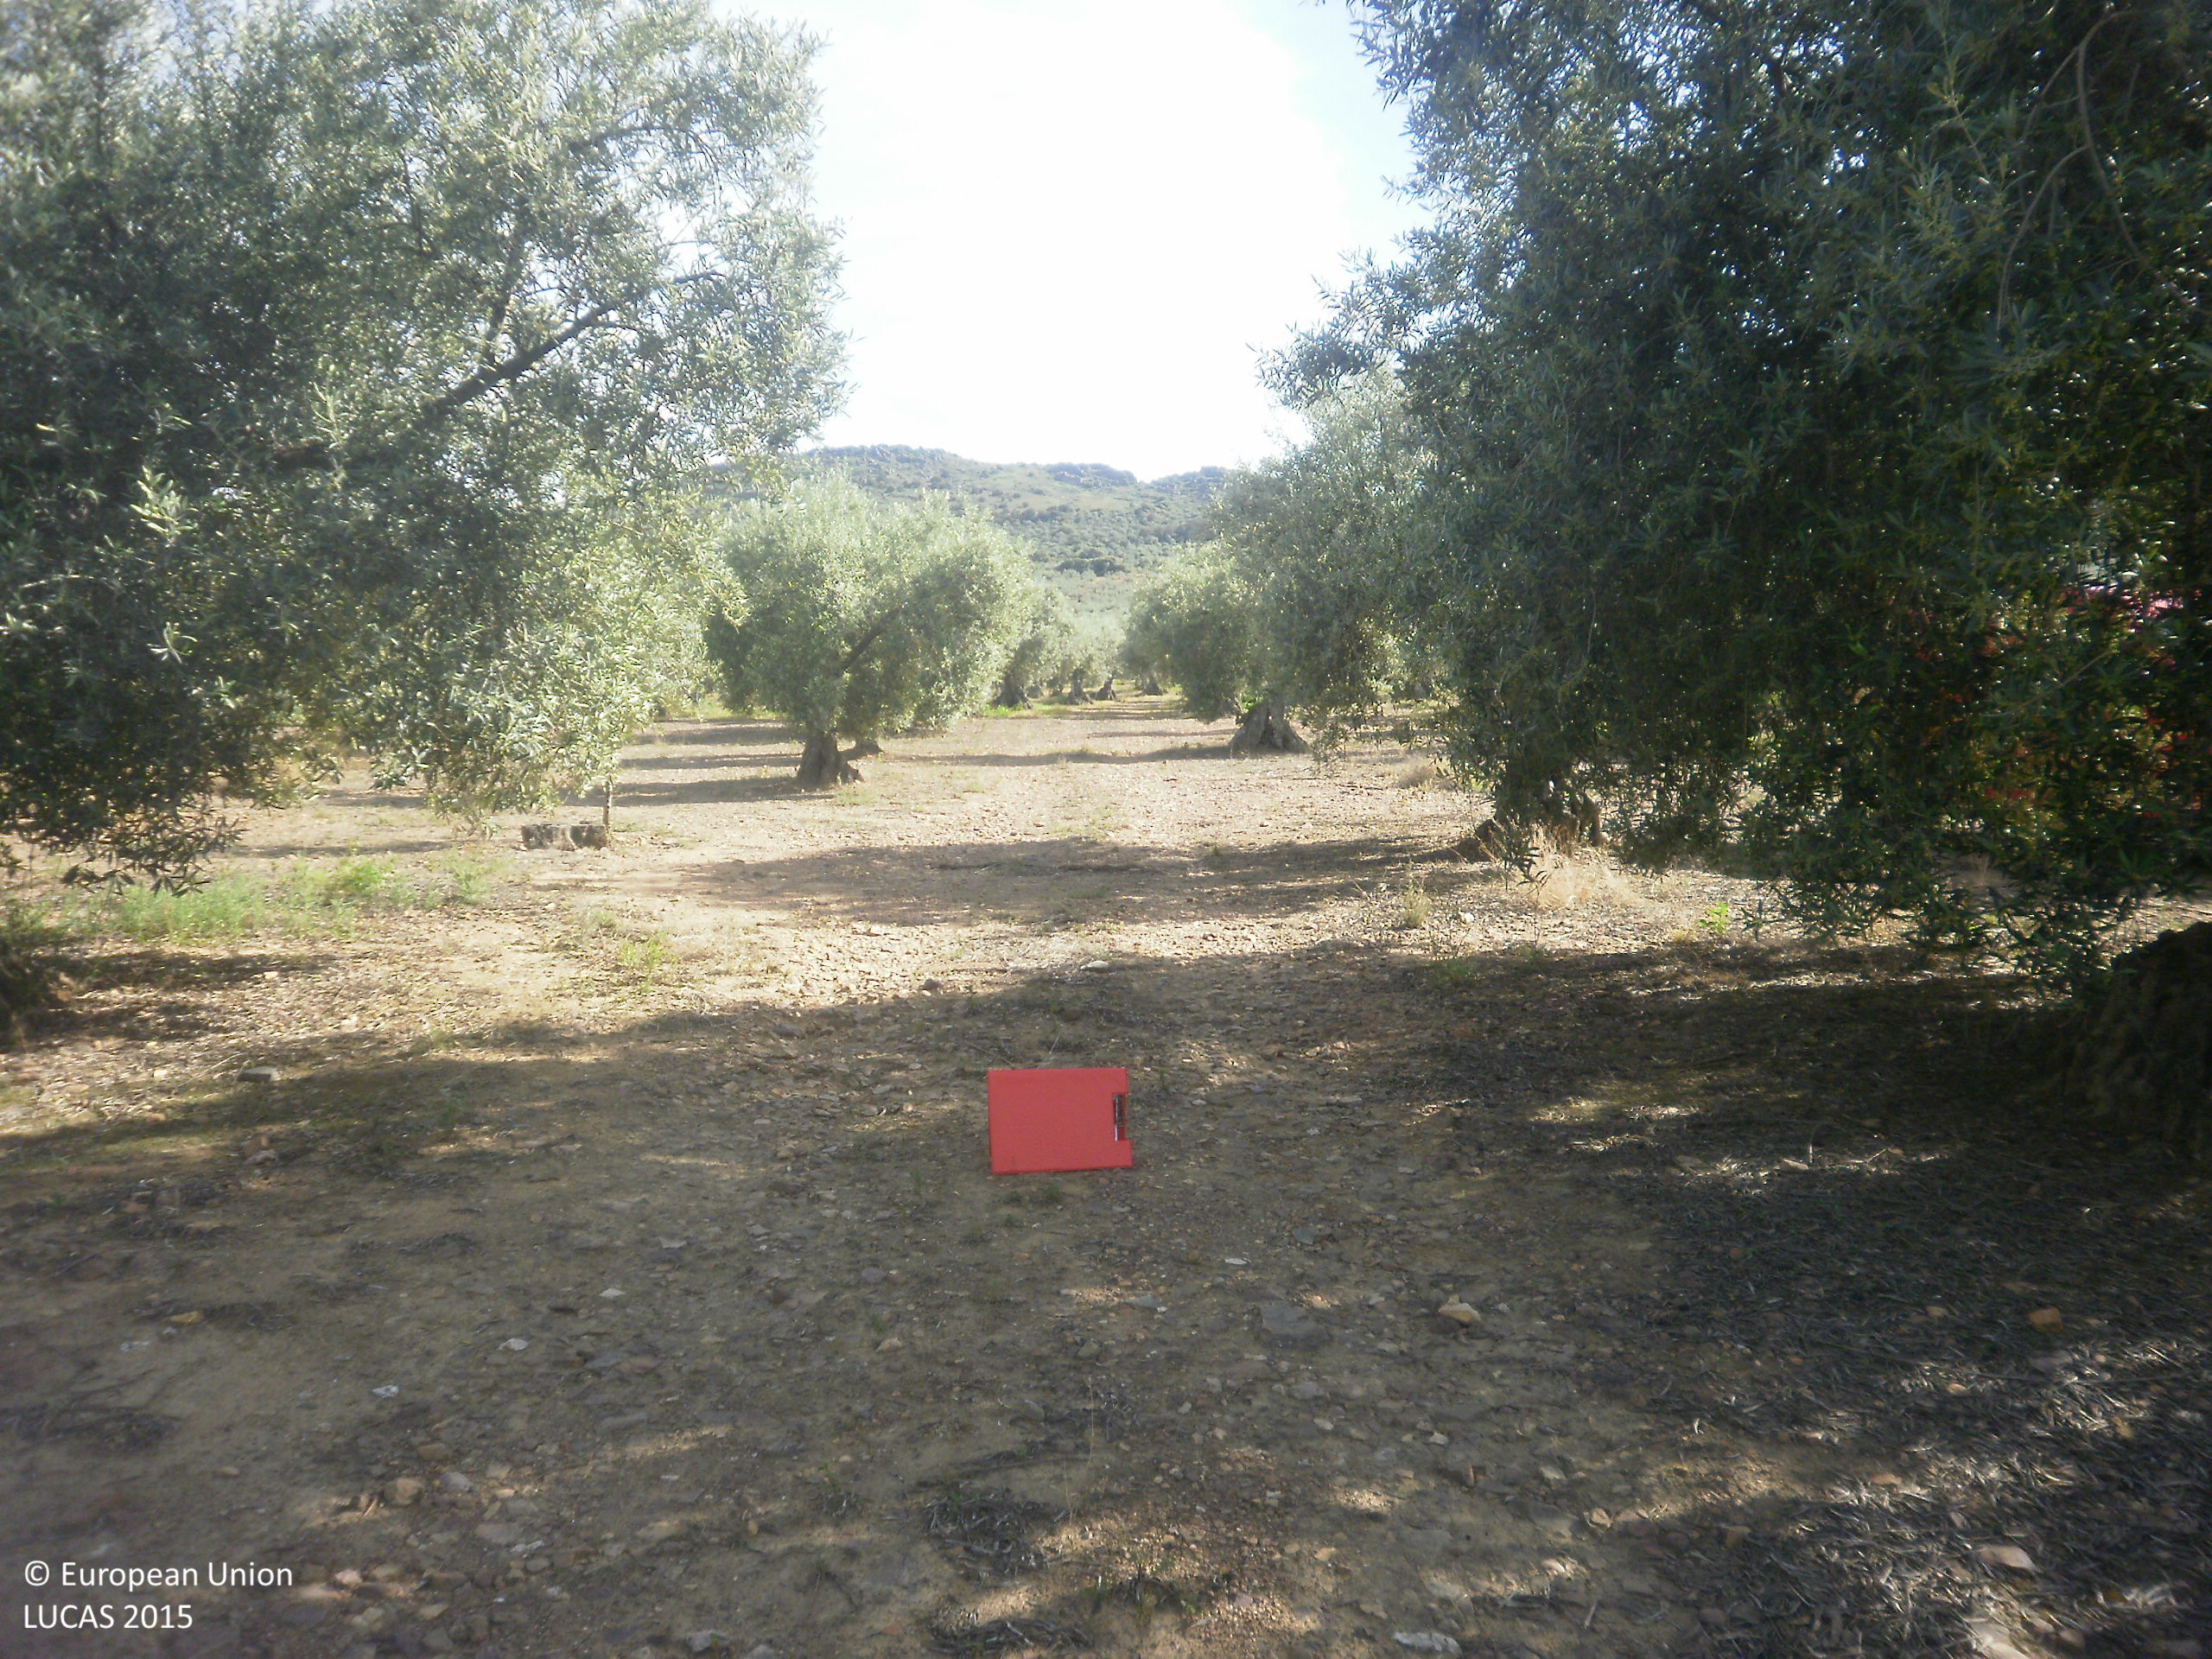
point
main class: Cropland
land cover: Olive groves
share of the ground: 50 - 75 %
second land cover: Grassland without tree/shrub cover
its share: 50 - 75 %
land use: Agriculture (excluding fallow land and kitchen gardens)
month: April
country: ES
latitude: 38.9909
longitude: -5.2679
